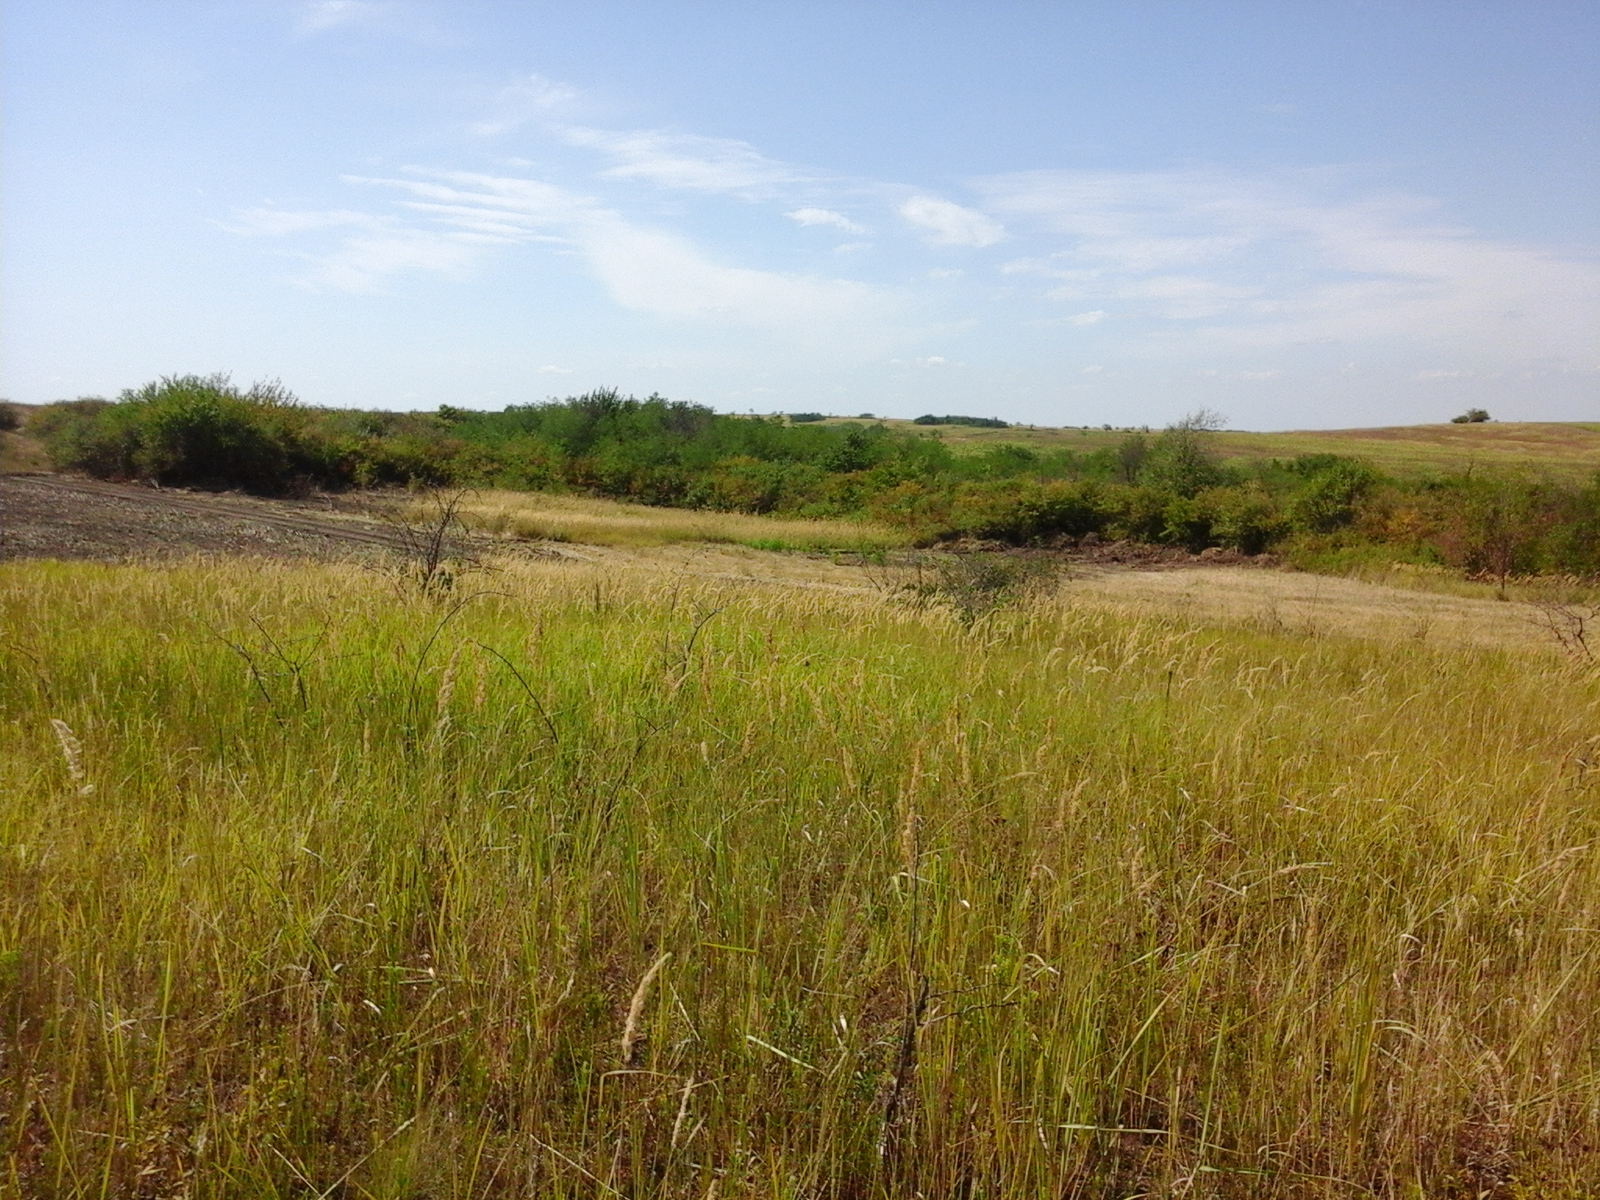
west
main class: Grassland
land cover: Grassland with sparse tree/shrub cover
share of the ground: > 75 %
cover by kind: herbaceous plants 95 %, broadleaved forest trees 5 %
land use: Agriculture (excluding fallow land and kitchen gardens)
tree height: < 5 m
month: August
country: RO
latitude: 45.2039
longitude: 21.4754
